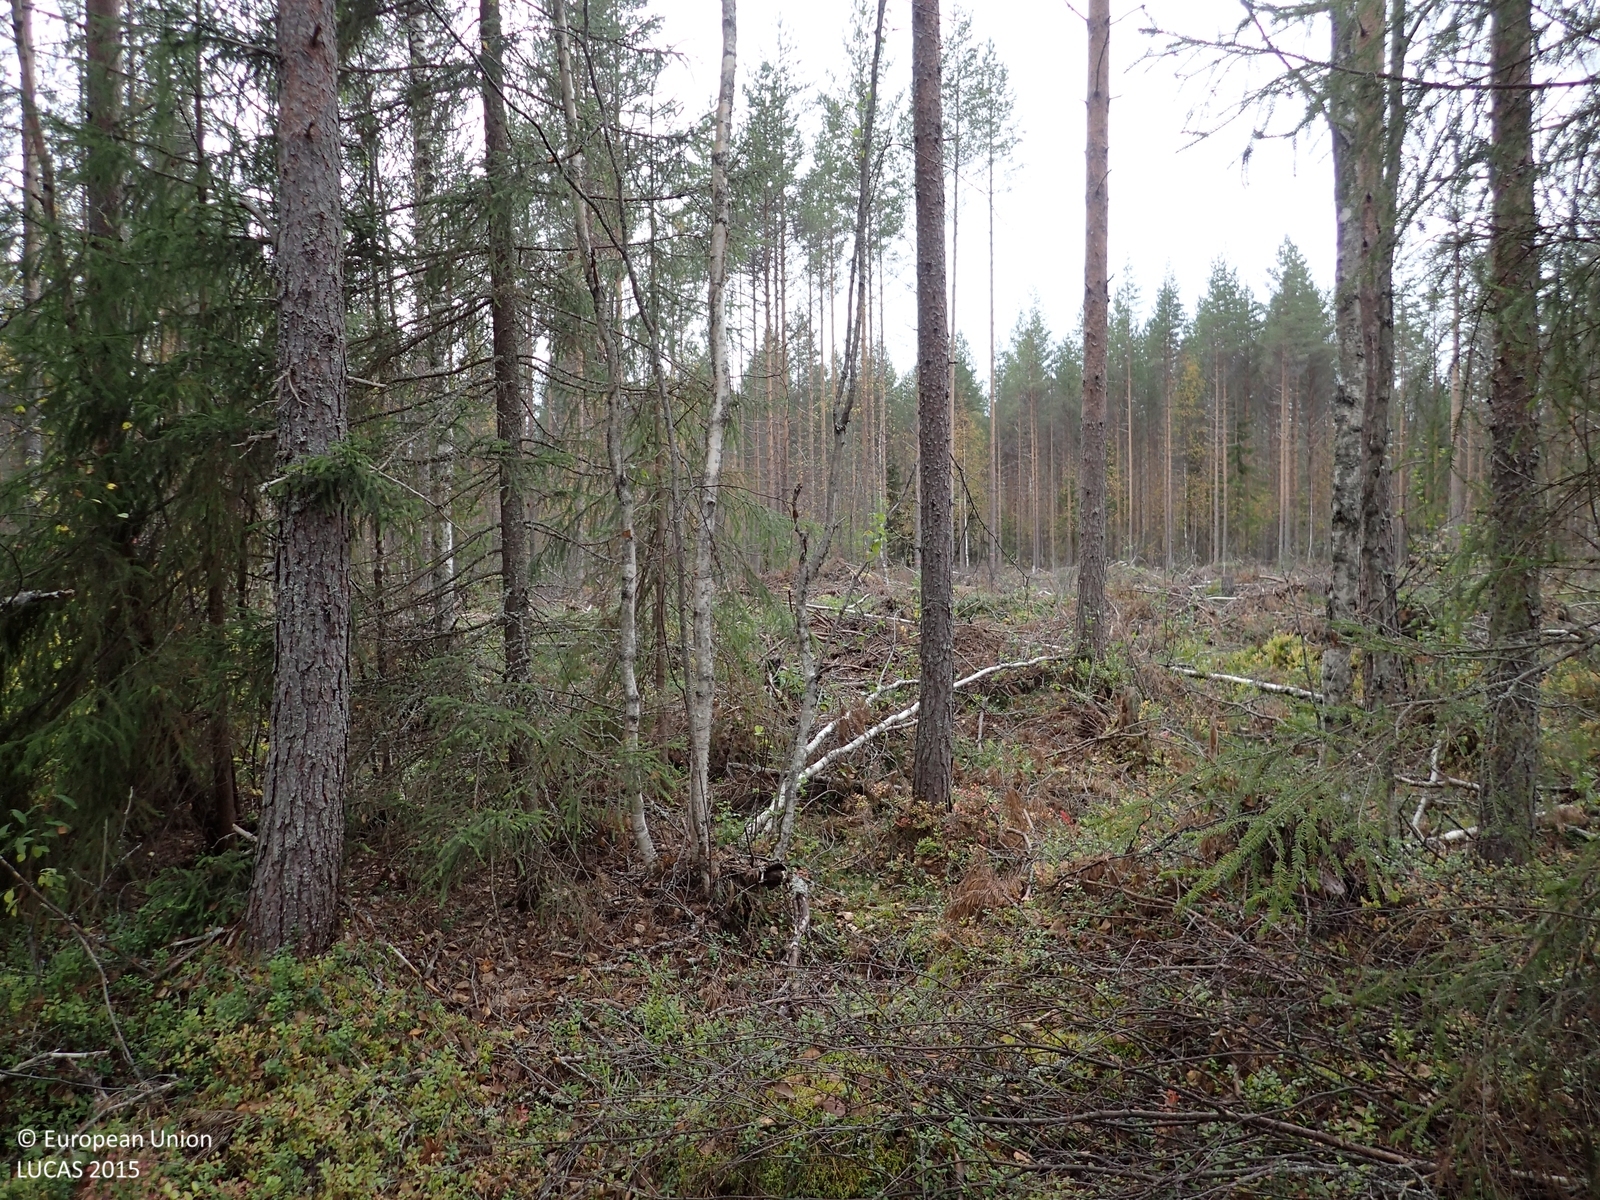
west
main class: Woodland
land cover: Pine dominated coniferous woodland
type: mire and swamp forests
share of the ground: 50 - 75 %
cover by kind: coniferous forest trees 65 %, shrubs 25 %, broadleaved forest trees 5 %, lichens and mosses 5 %
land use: Forestry
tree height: > 5 m
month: September
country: FI
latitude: 63.3068
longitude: 25.4054
